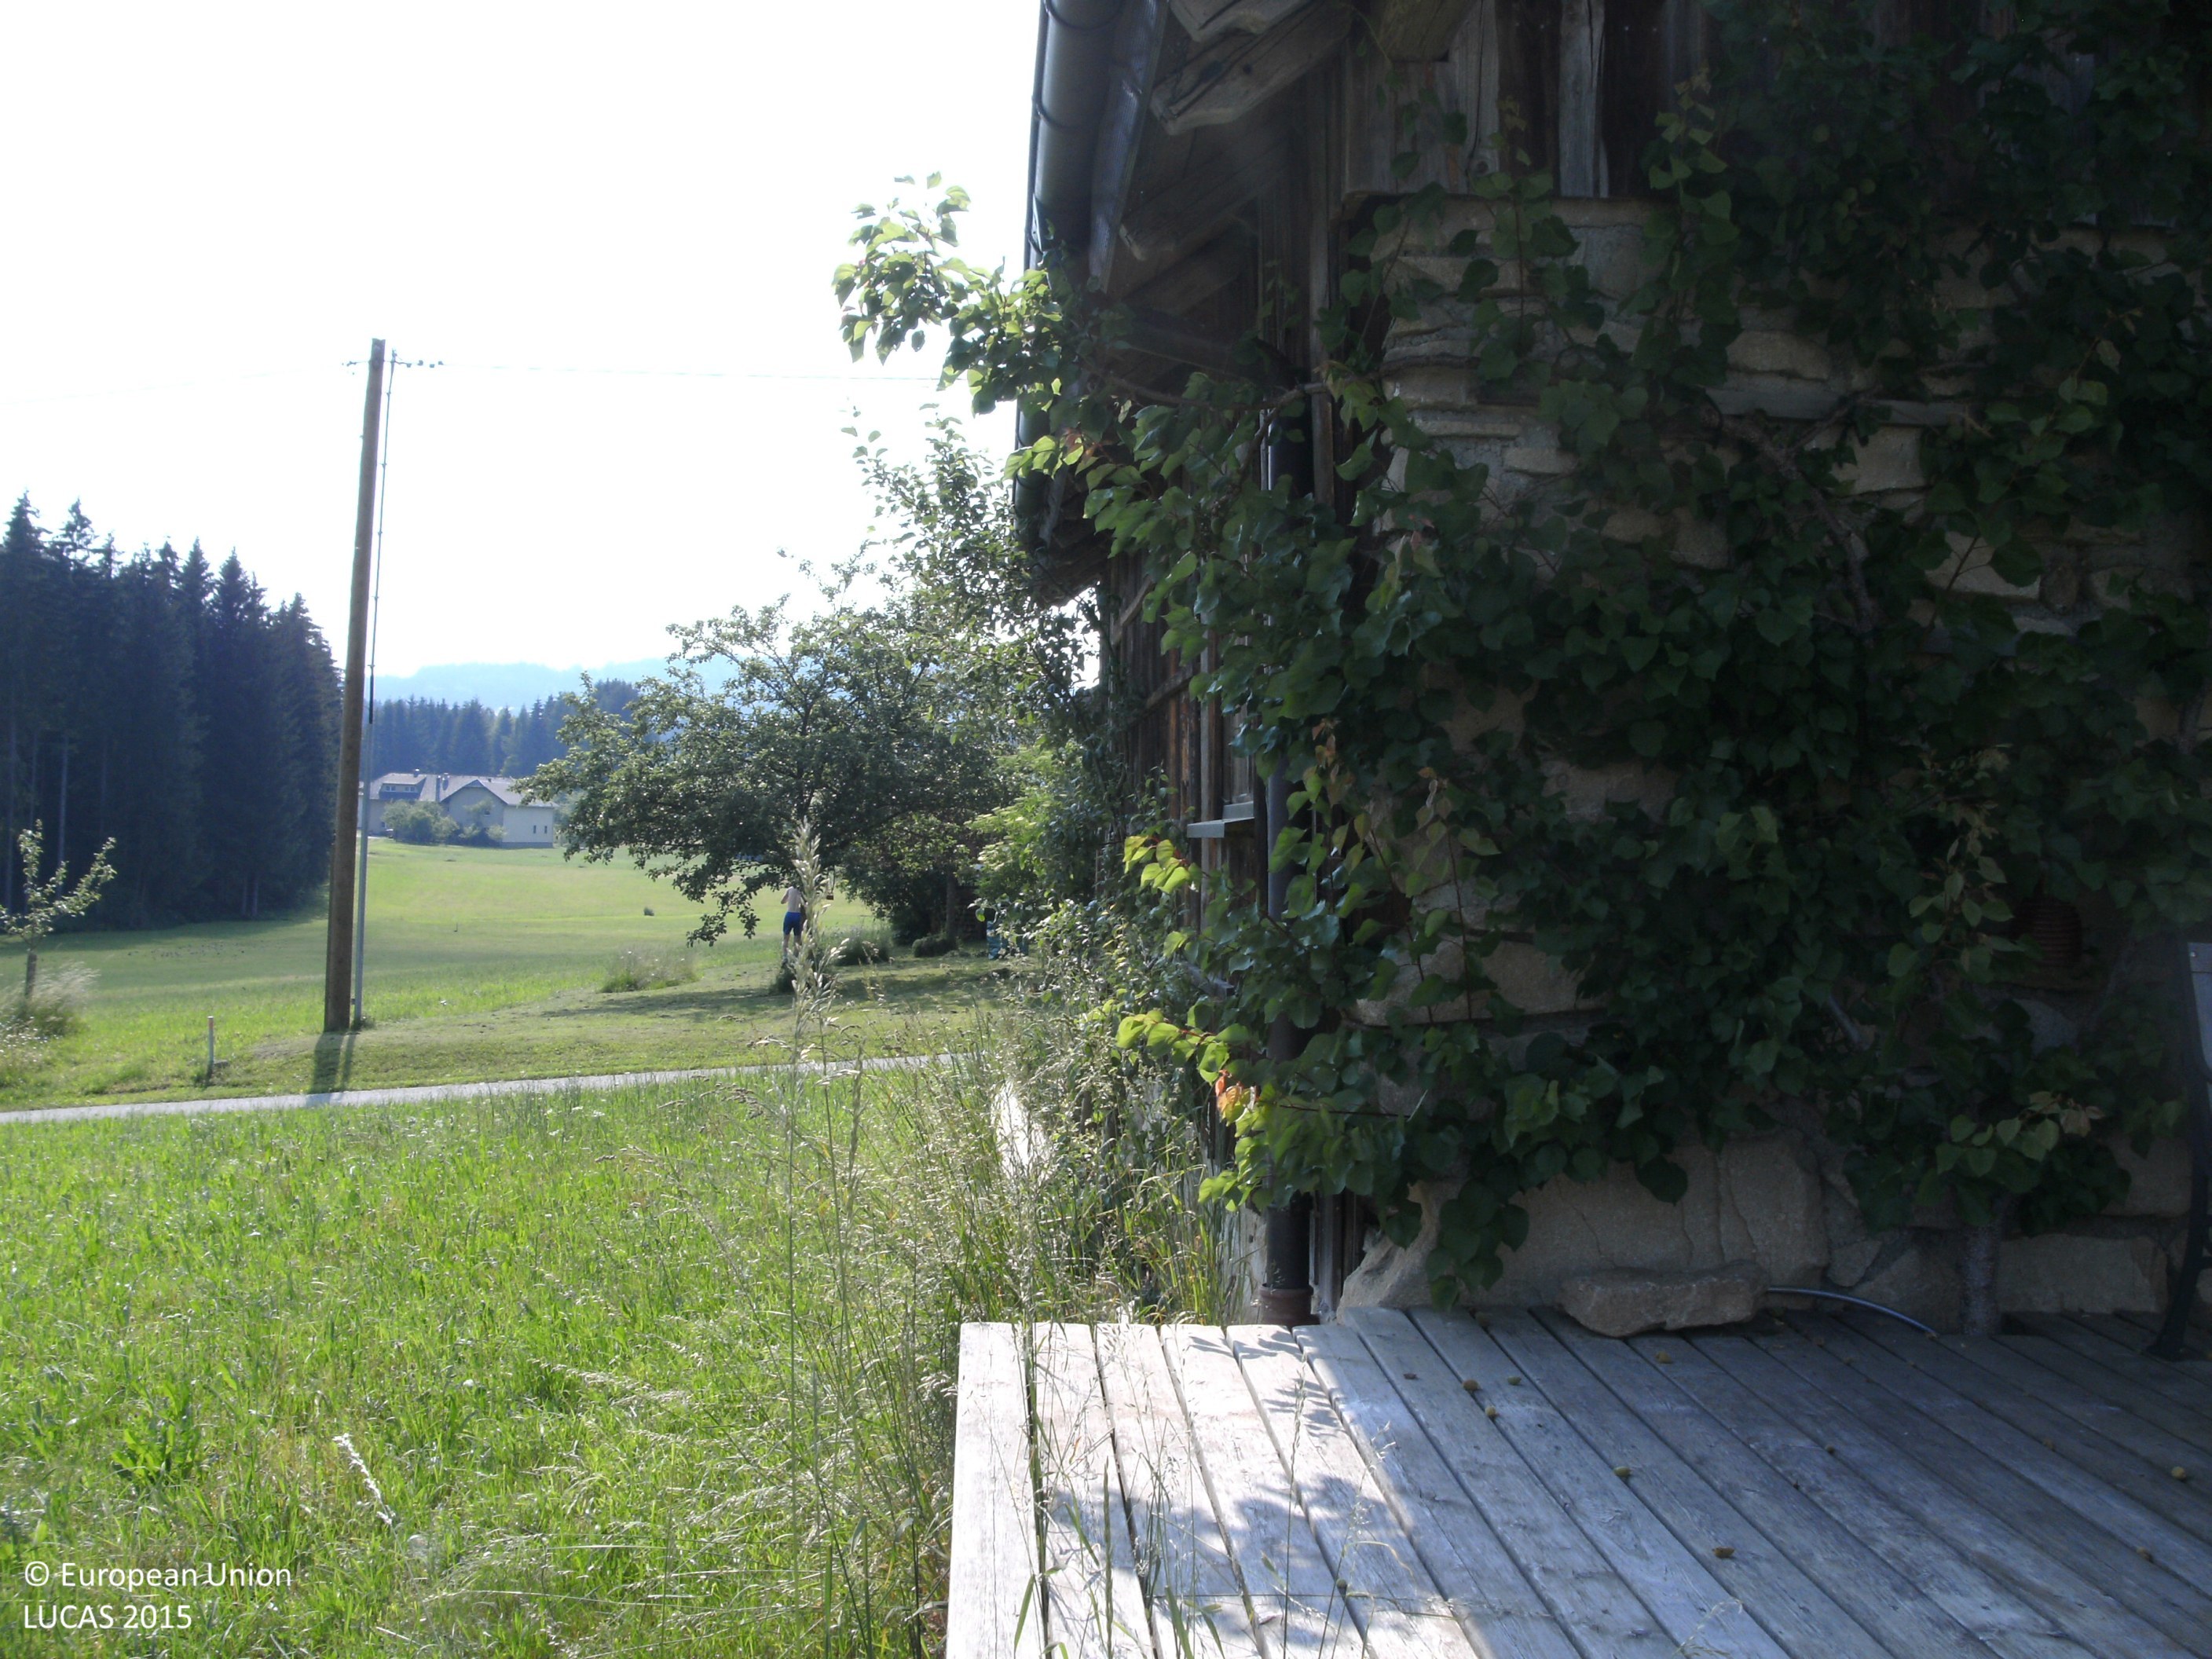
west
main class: Grassland
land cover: Grassland without tree/shrub cover
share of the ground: > 75 %
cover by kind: herbaceous plants 95 %, shrubs 5 %
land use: Residential
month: June
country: AT
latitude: 48.5025
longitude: 14.2366
